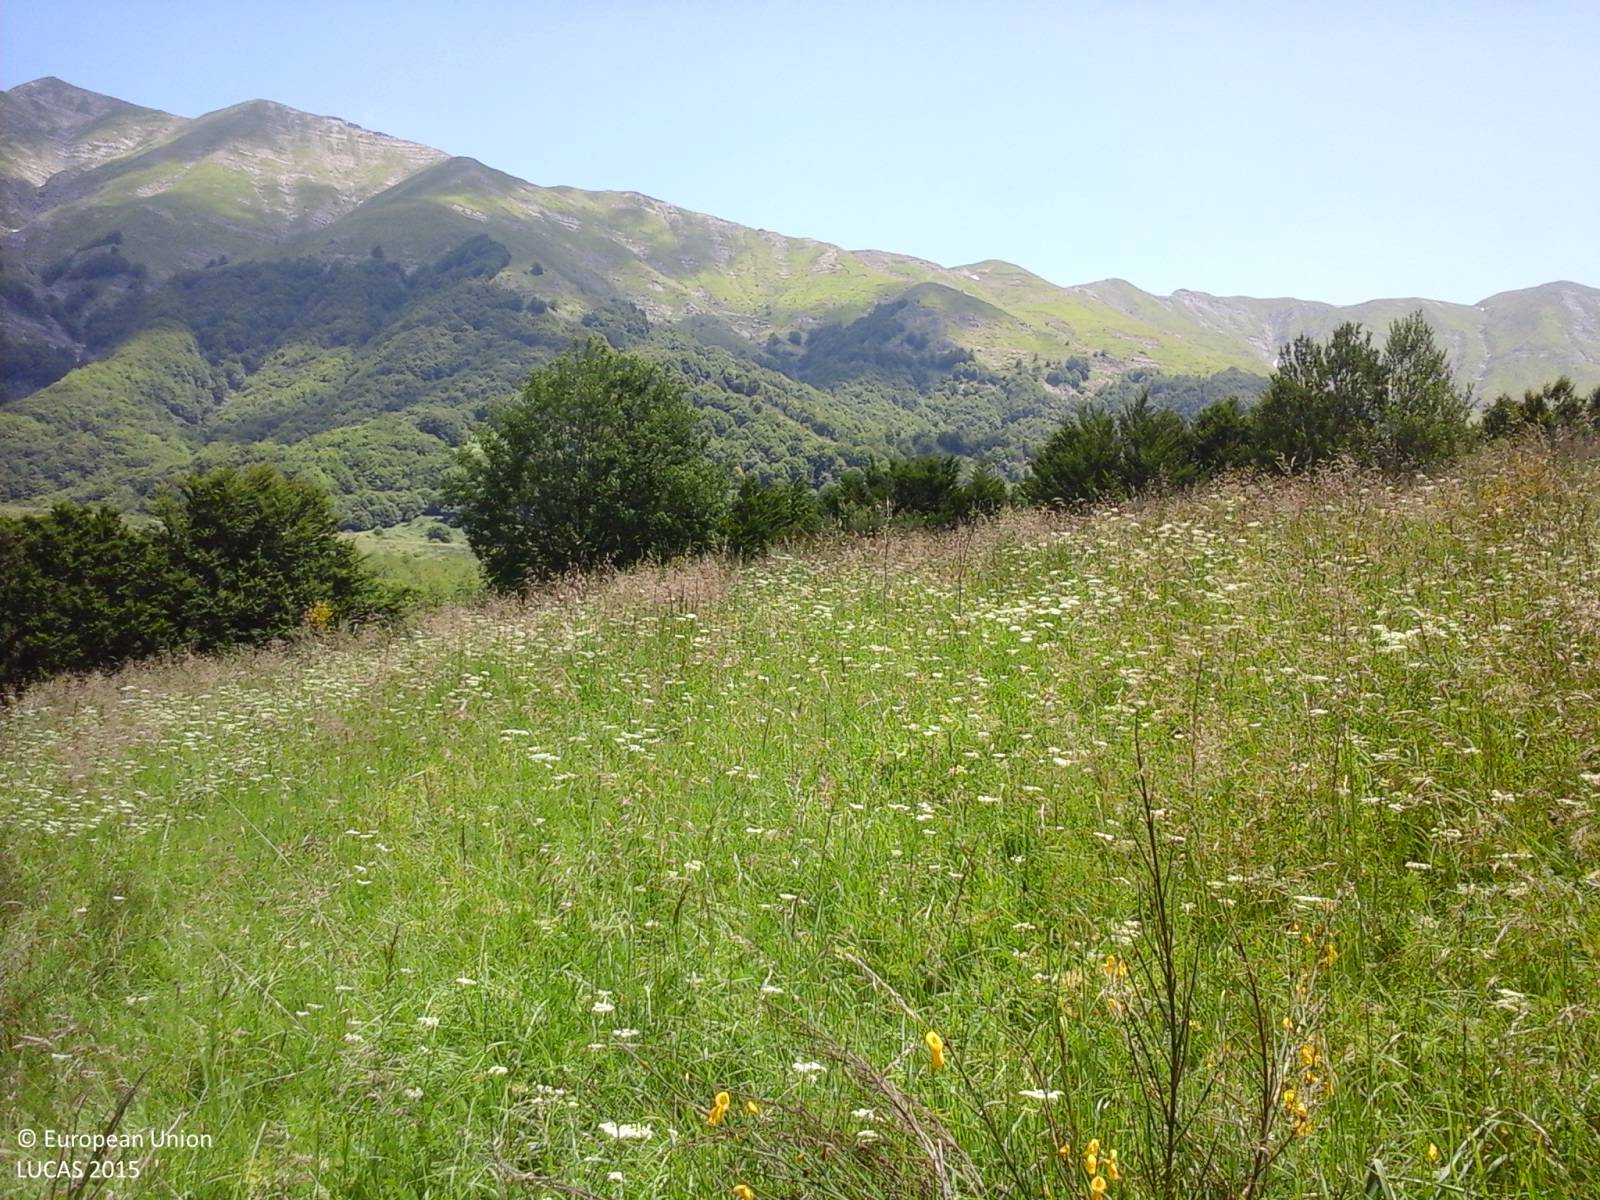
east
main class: Shrubland
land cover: Shrubland without tree cover
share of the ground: > 75 %
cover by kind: herbaceous plants 80 %, shrubs 20 %
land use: Semi-natural and natural areas not in use
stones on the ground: < 10 %
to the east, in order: Shrubland without tree cover; Grassland without tree/shrub cover; Shrubland without tree cover; Rivers and streams; Broadleaved woodland; Grassland with sparse tree/shrub cover; Broadleaved woodland; Tracks; Shrubland with sparse tree cover
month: September
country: IT
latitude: 42.5801
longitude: 13.3647
